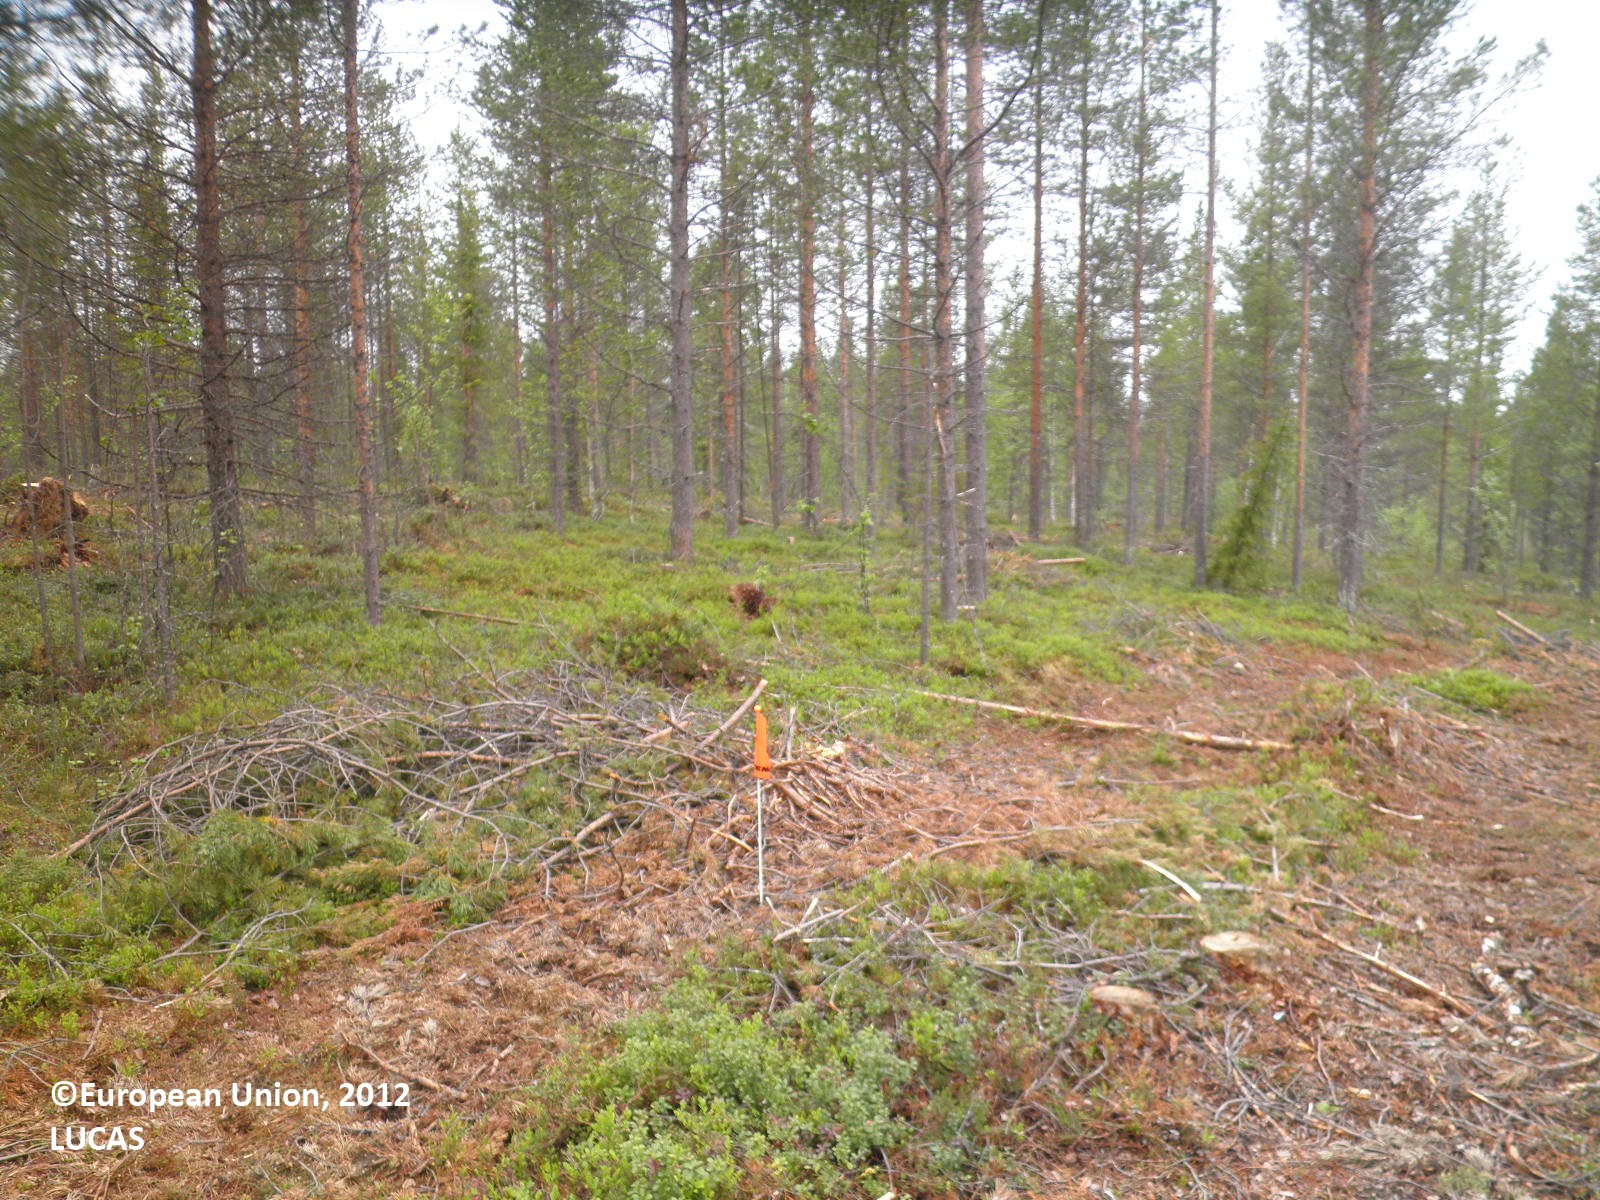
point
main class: Woodland
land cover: Pine dominated coniferous woodland
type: boreal forest
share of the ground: 25 - 50 %
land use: Forestry
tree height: > 5 m
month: June
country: FI
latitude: 67.8137
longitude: 25.5408
